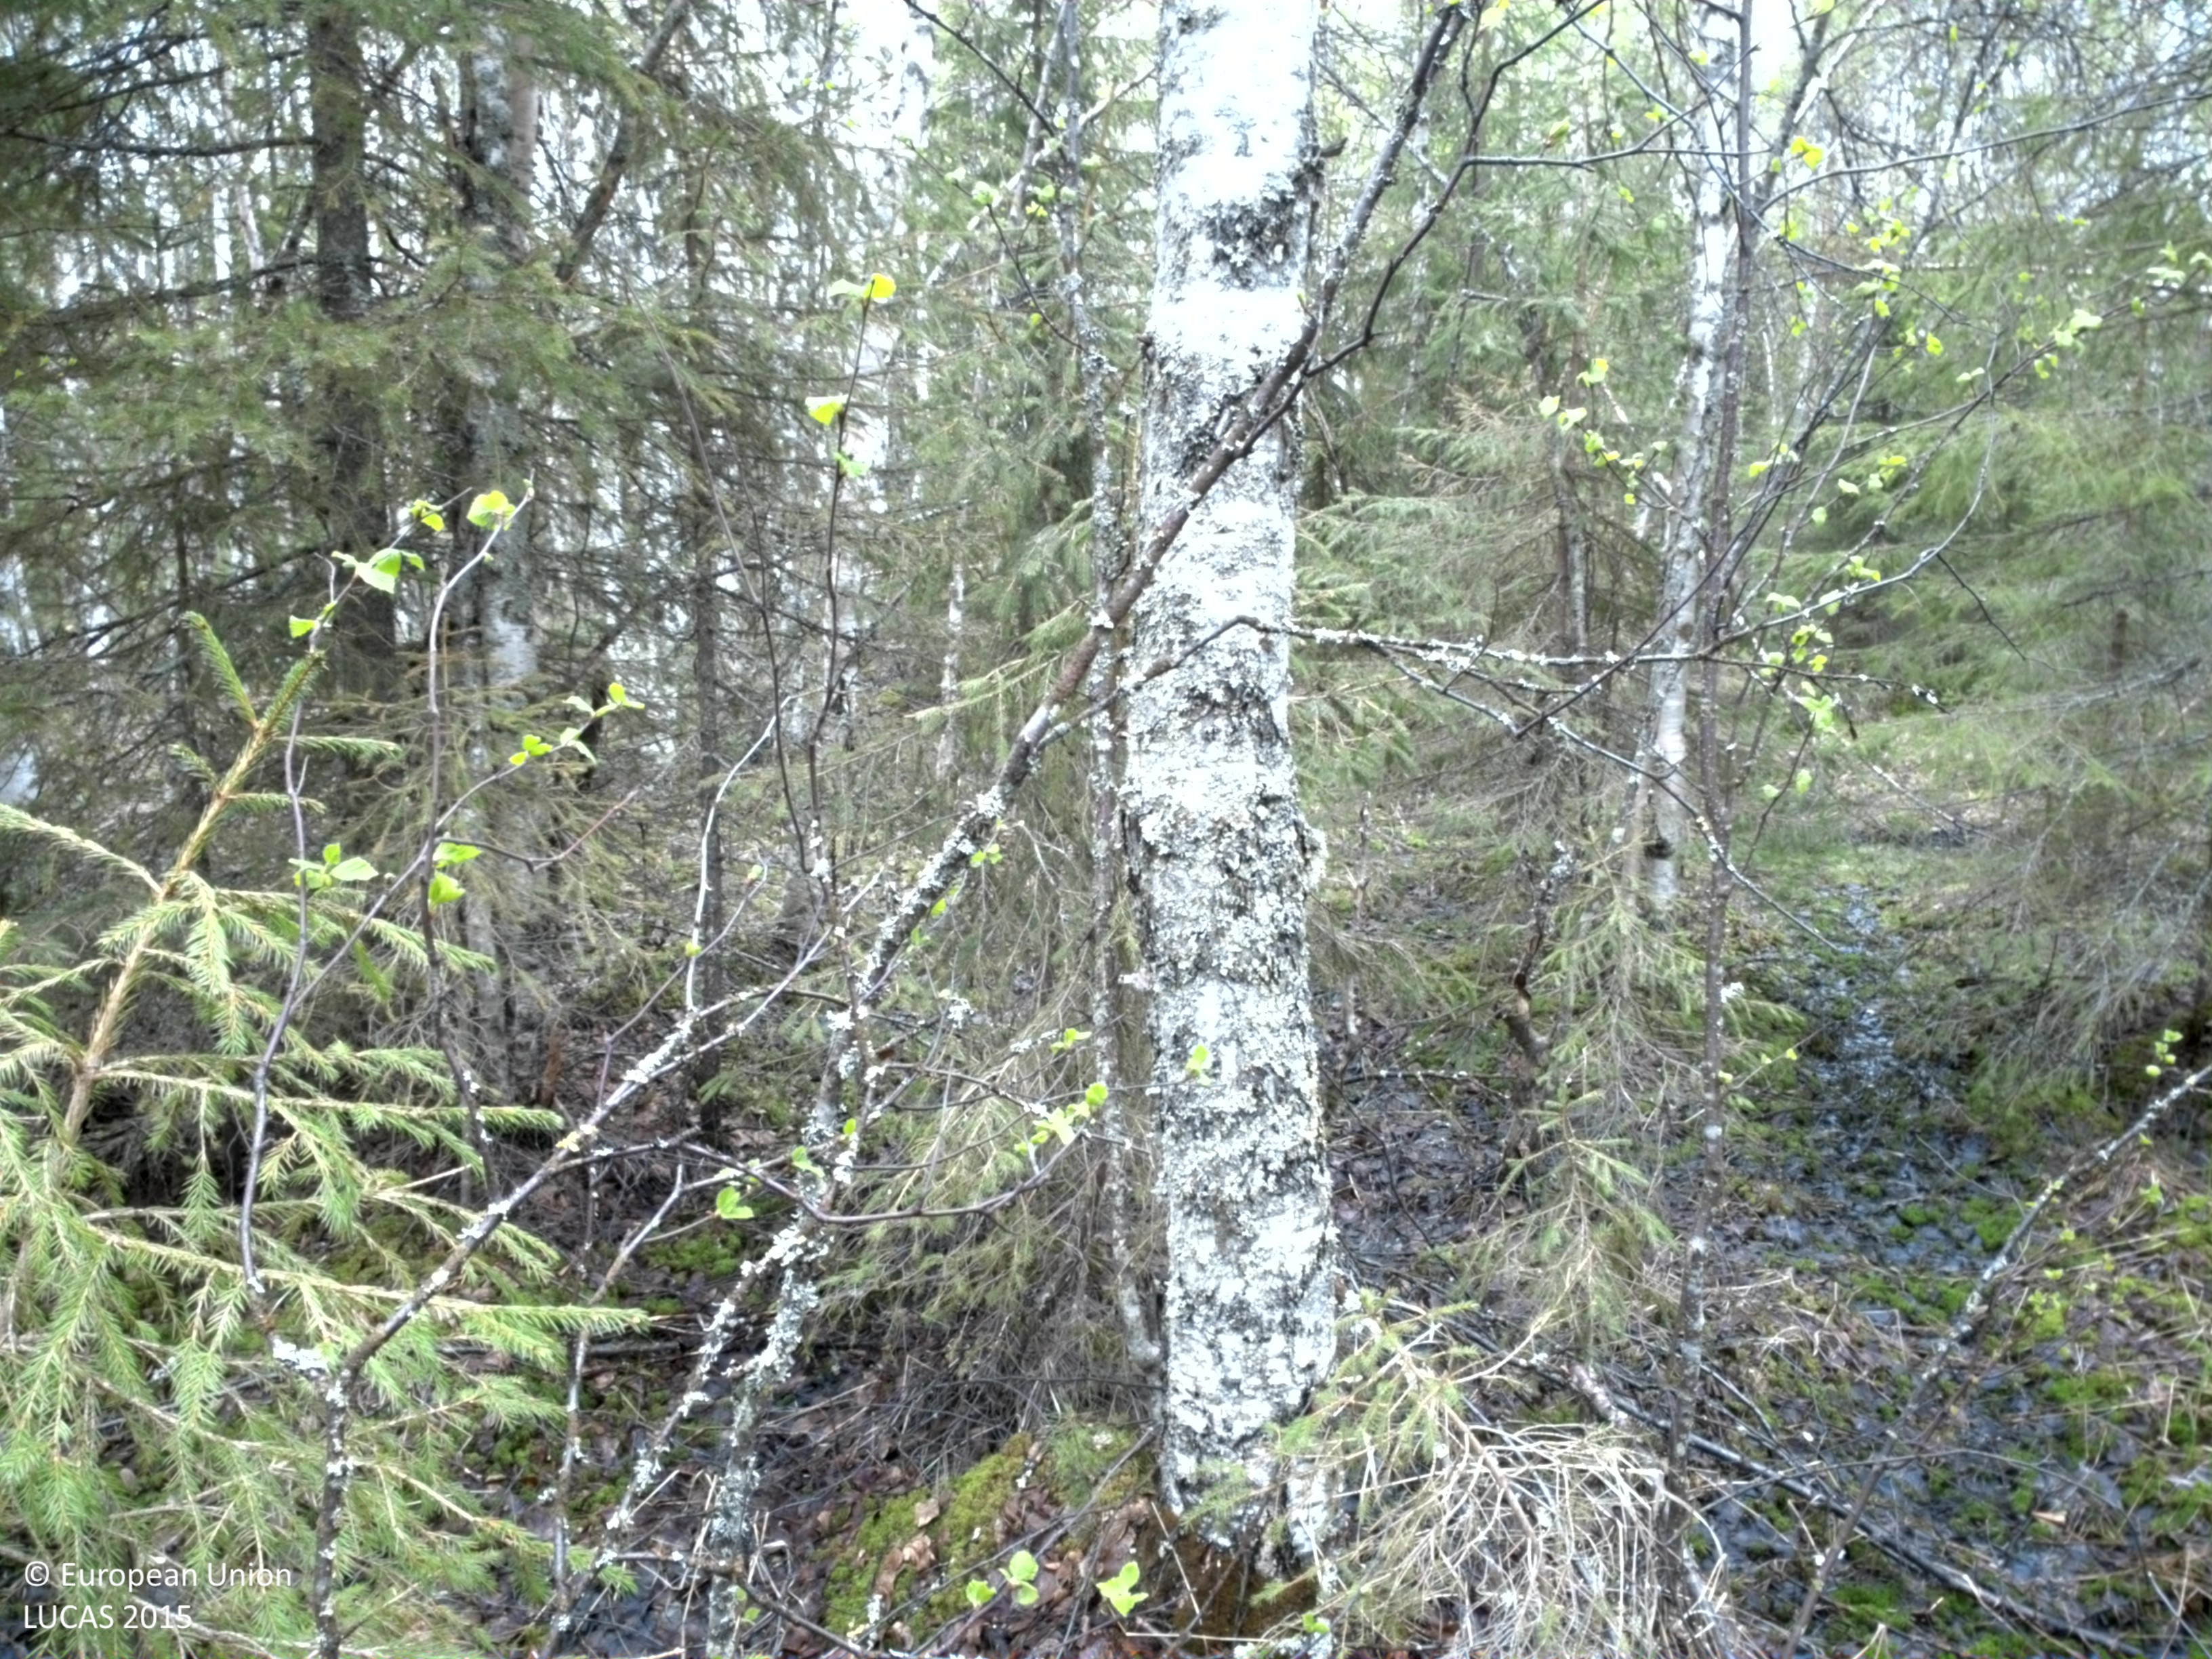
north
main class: Woodland
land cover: Broadleaved woodland
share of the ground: > 75 %
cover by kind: broadleaved forest trees 75 %, coniferous forest trees 10 %, lichens and mosses 10 %, herbaceous plants 5 %
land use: Forestry
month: June
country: SE
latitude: 65.9327
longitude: 23.2840
